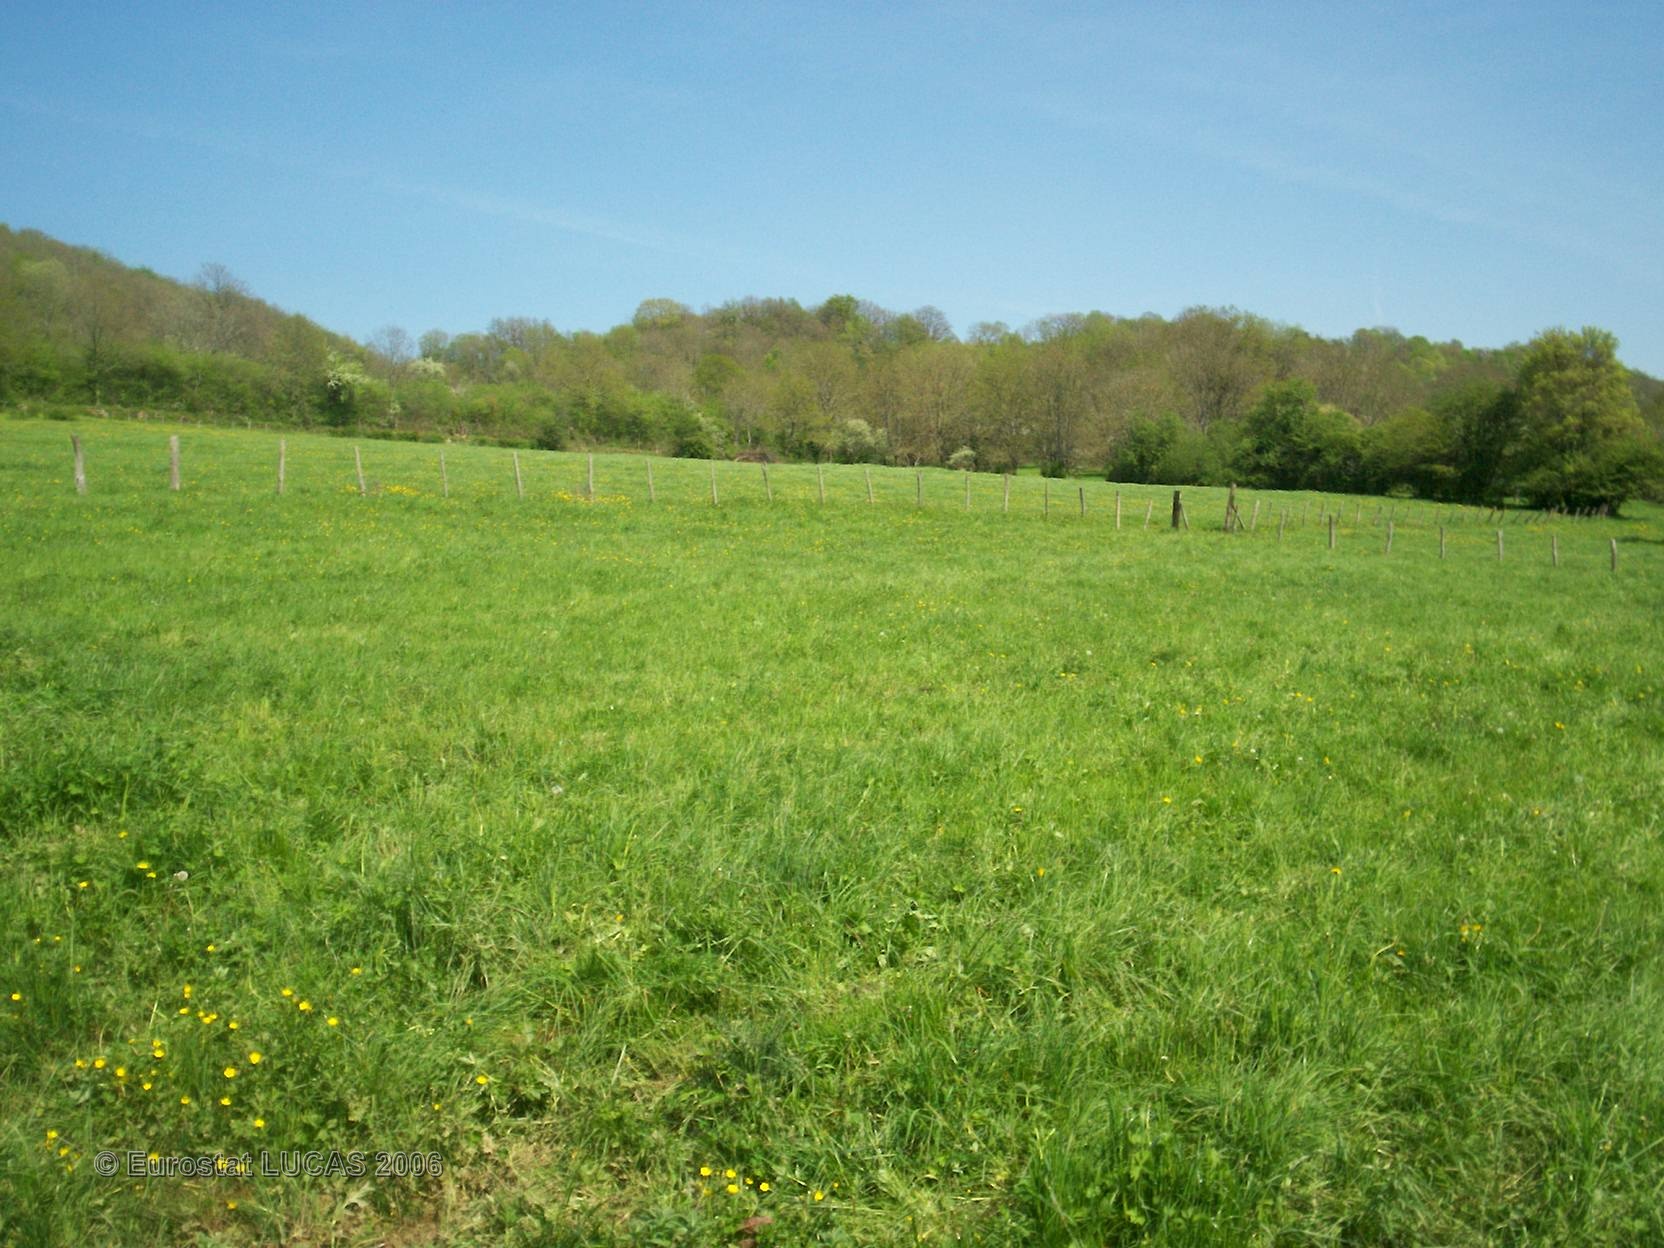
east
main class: Grassland
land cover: Grassland without tree/shrub cover
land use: Agriculture (excluding fallow land and kitchen gardens)
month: May
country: FR
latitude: 47.5331
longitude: 4.6195
